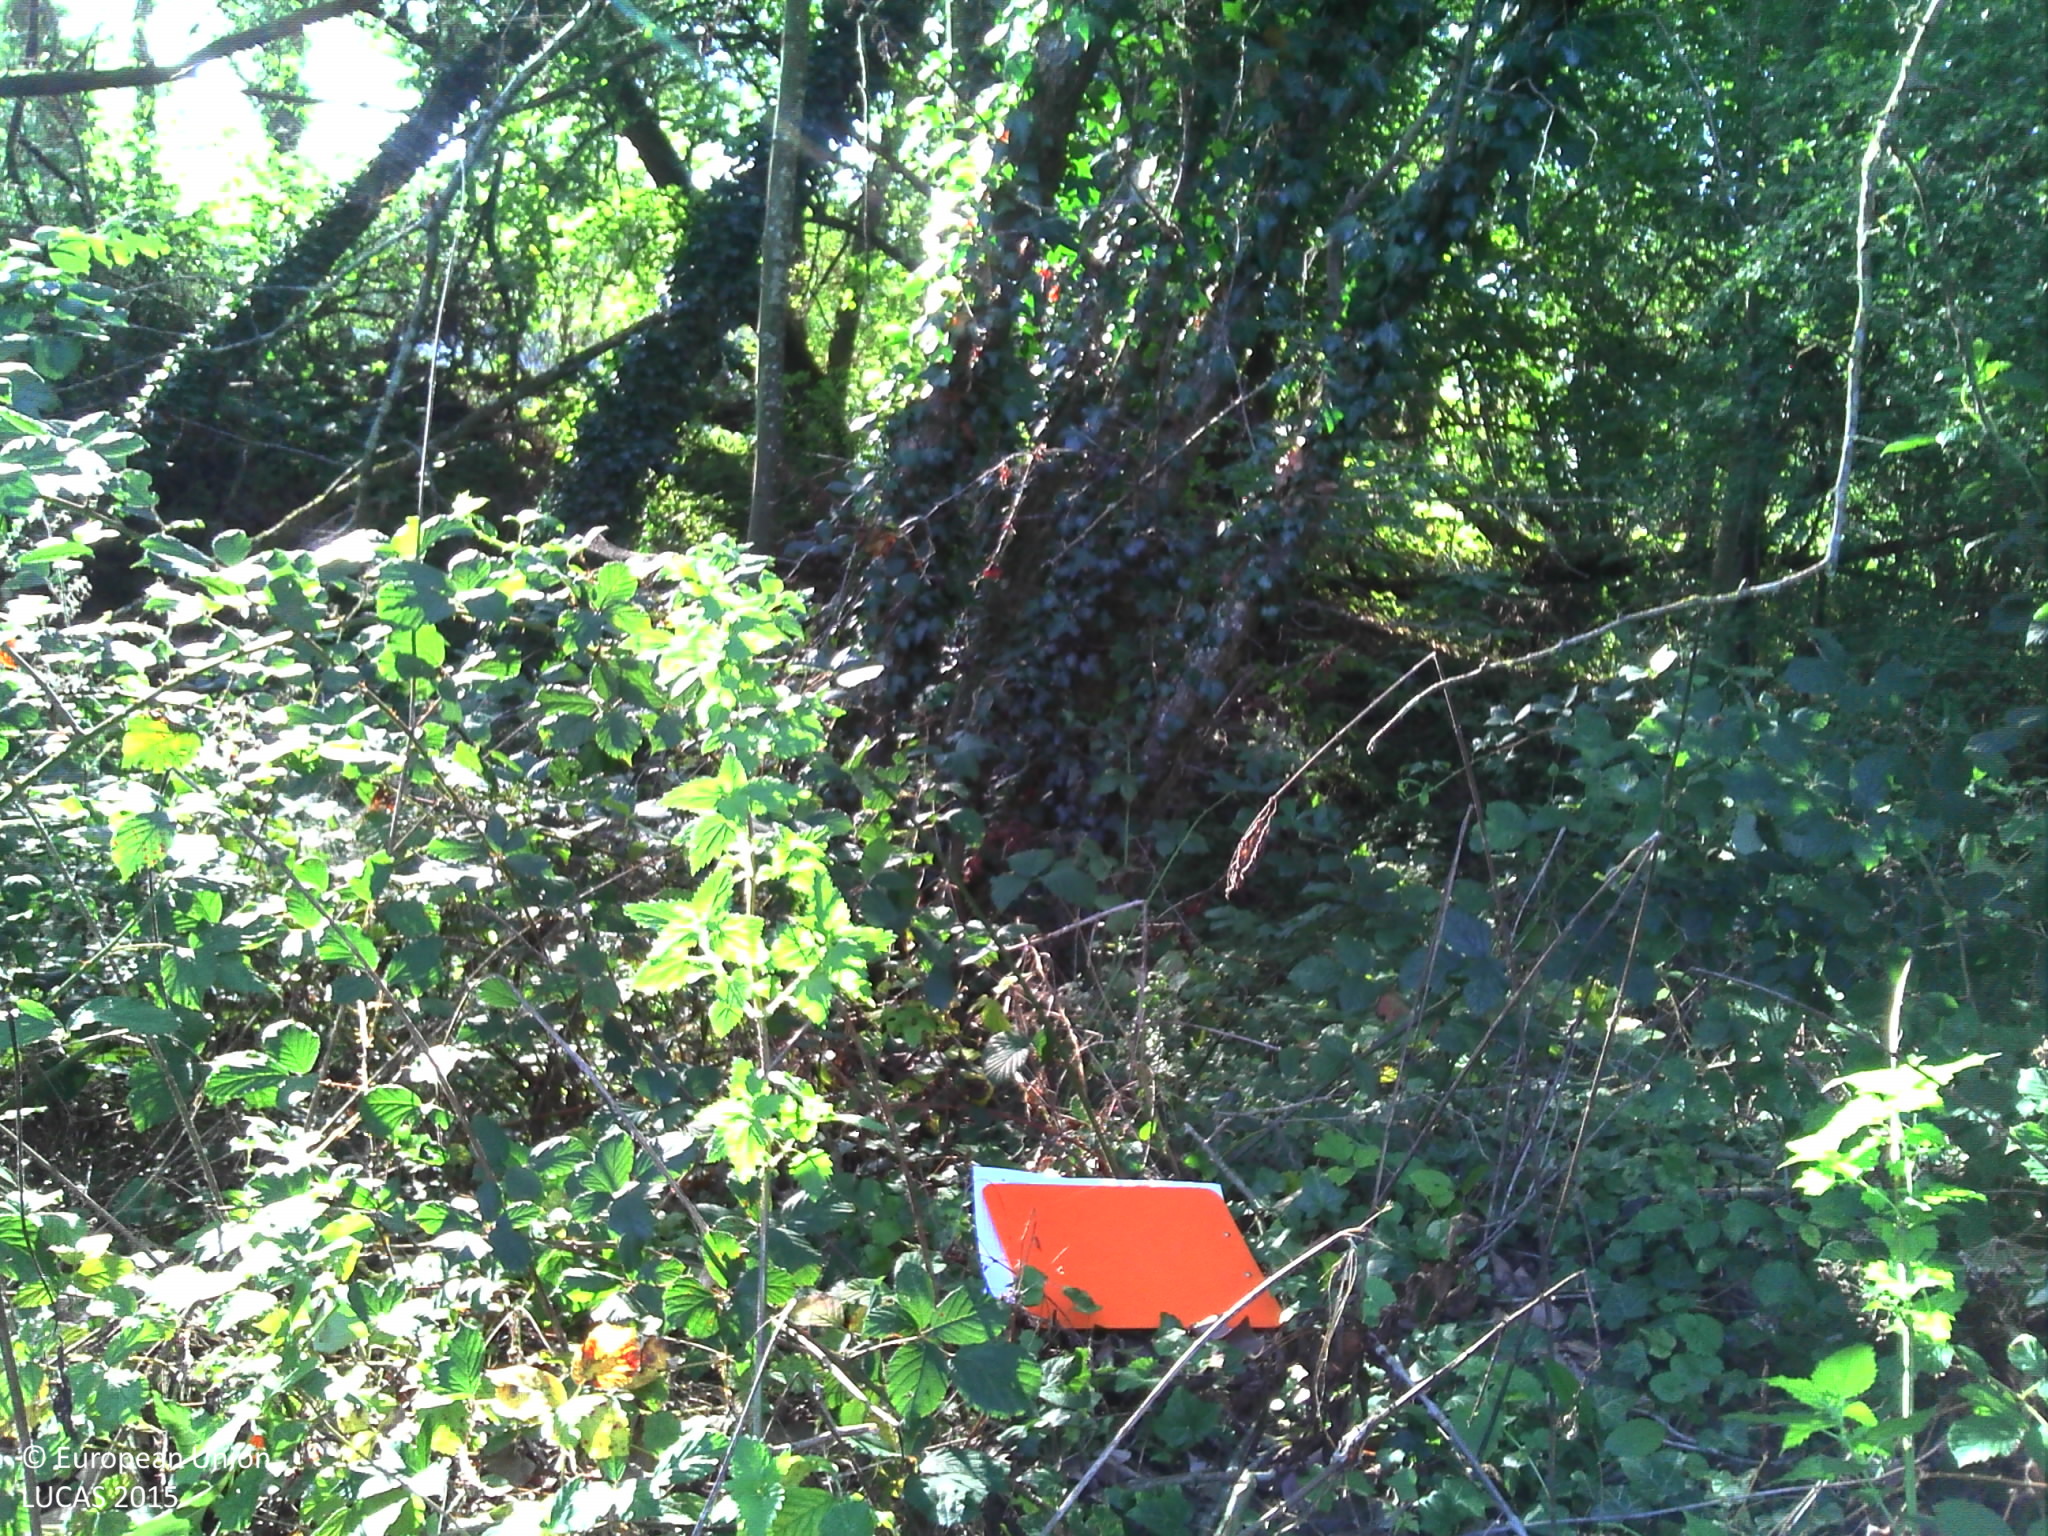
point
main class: Woodland
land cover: Broadleaved woodland
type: floodplain forest
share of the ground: > 75 %
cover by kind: broadleaved forest trees 85 %, herbaceous plants 10 %, consolidated bare surface 5 %
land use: Semi-natural and natural areas not in use
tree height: > 5 m
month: September
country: FR
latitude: 48.4123
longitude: 6.2580
